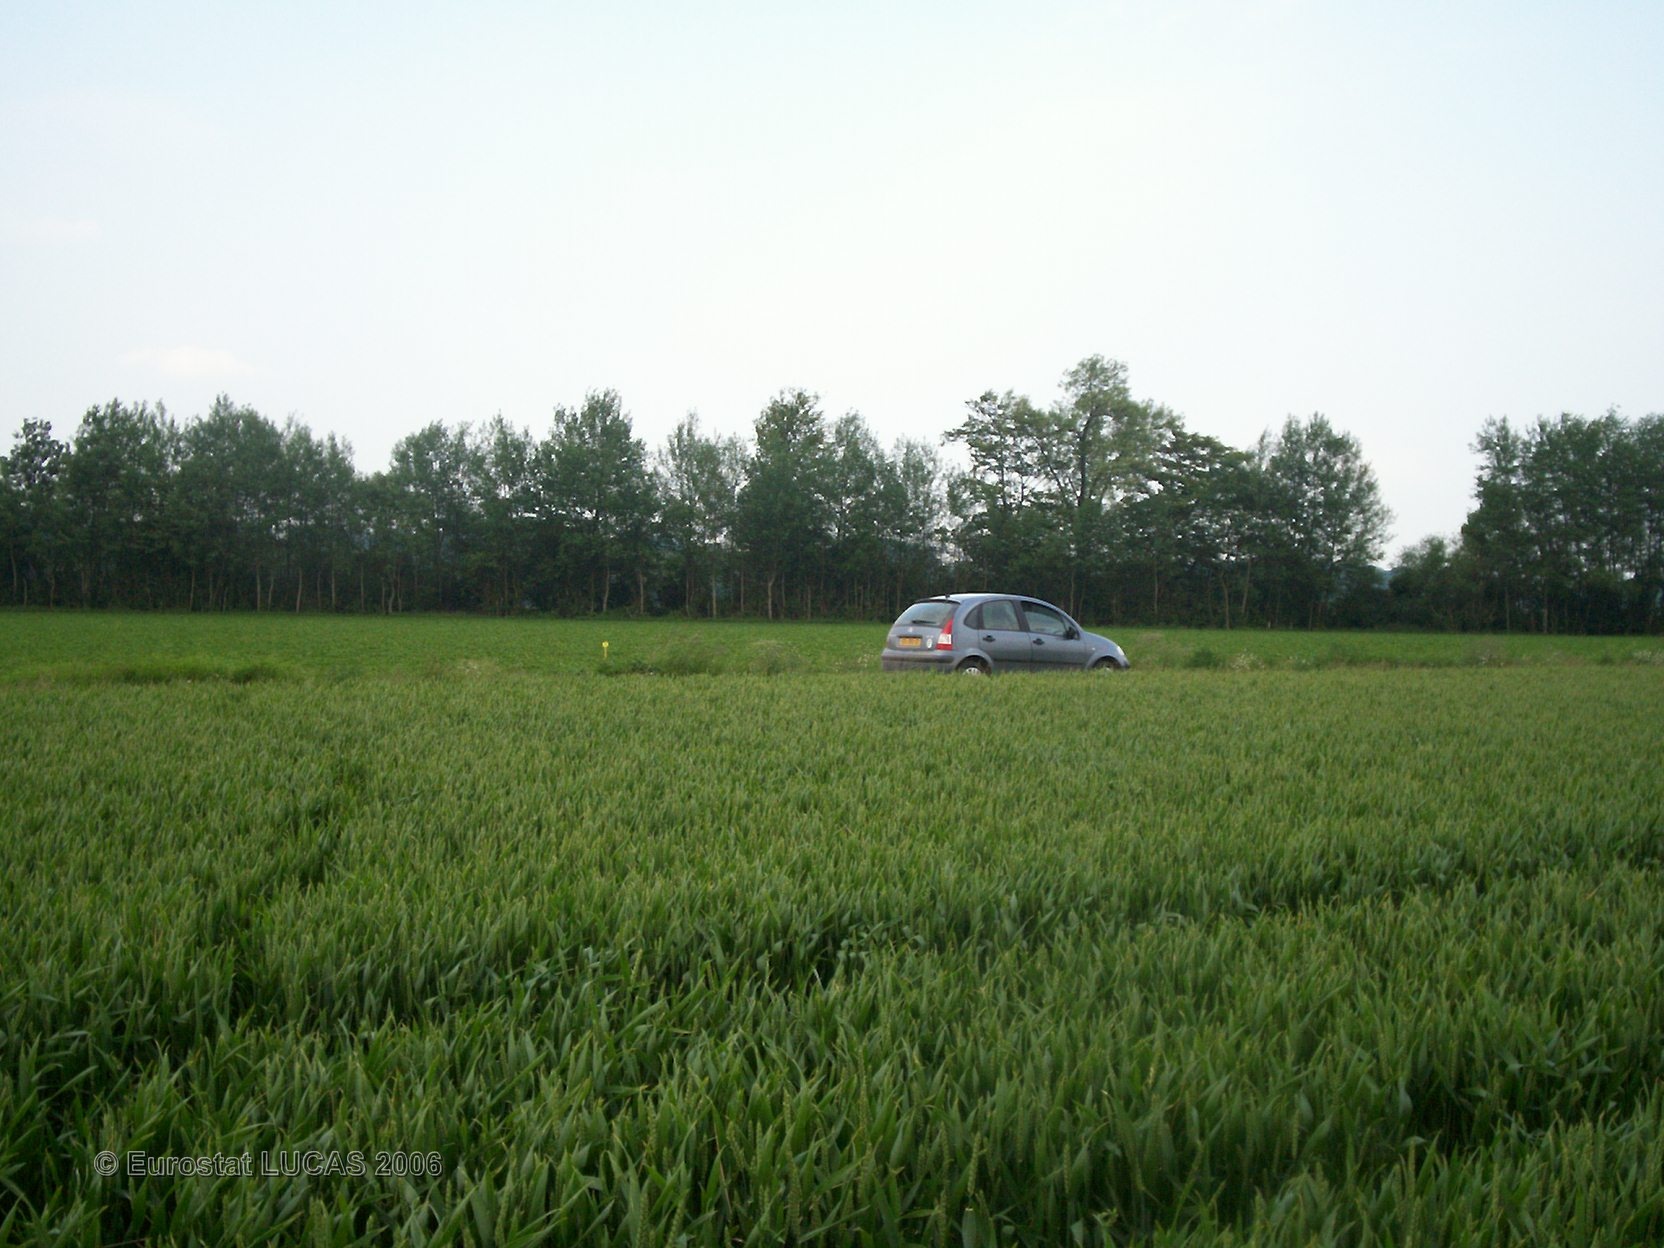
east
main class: Cropland
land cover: Common wheat
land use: Agriculture (excluding fallow land and kitchen gardens)
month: June
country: FR
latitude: 49.6032
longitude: 2.6411
